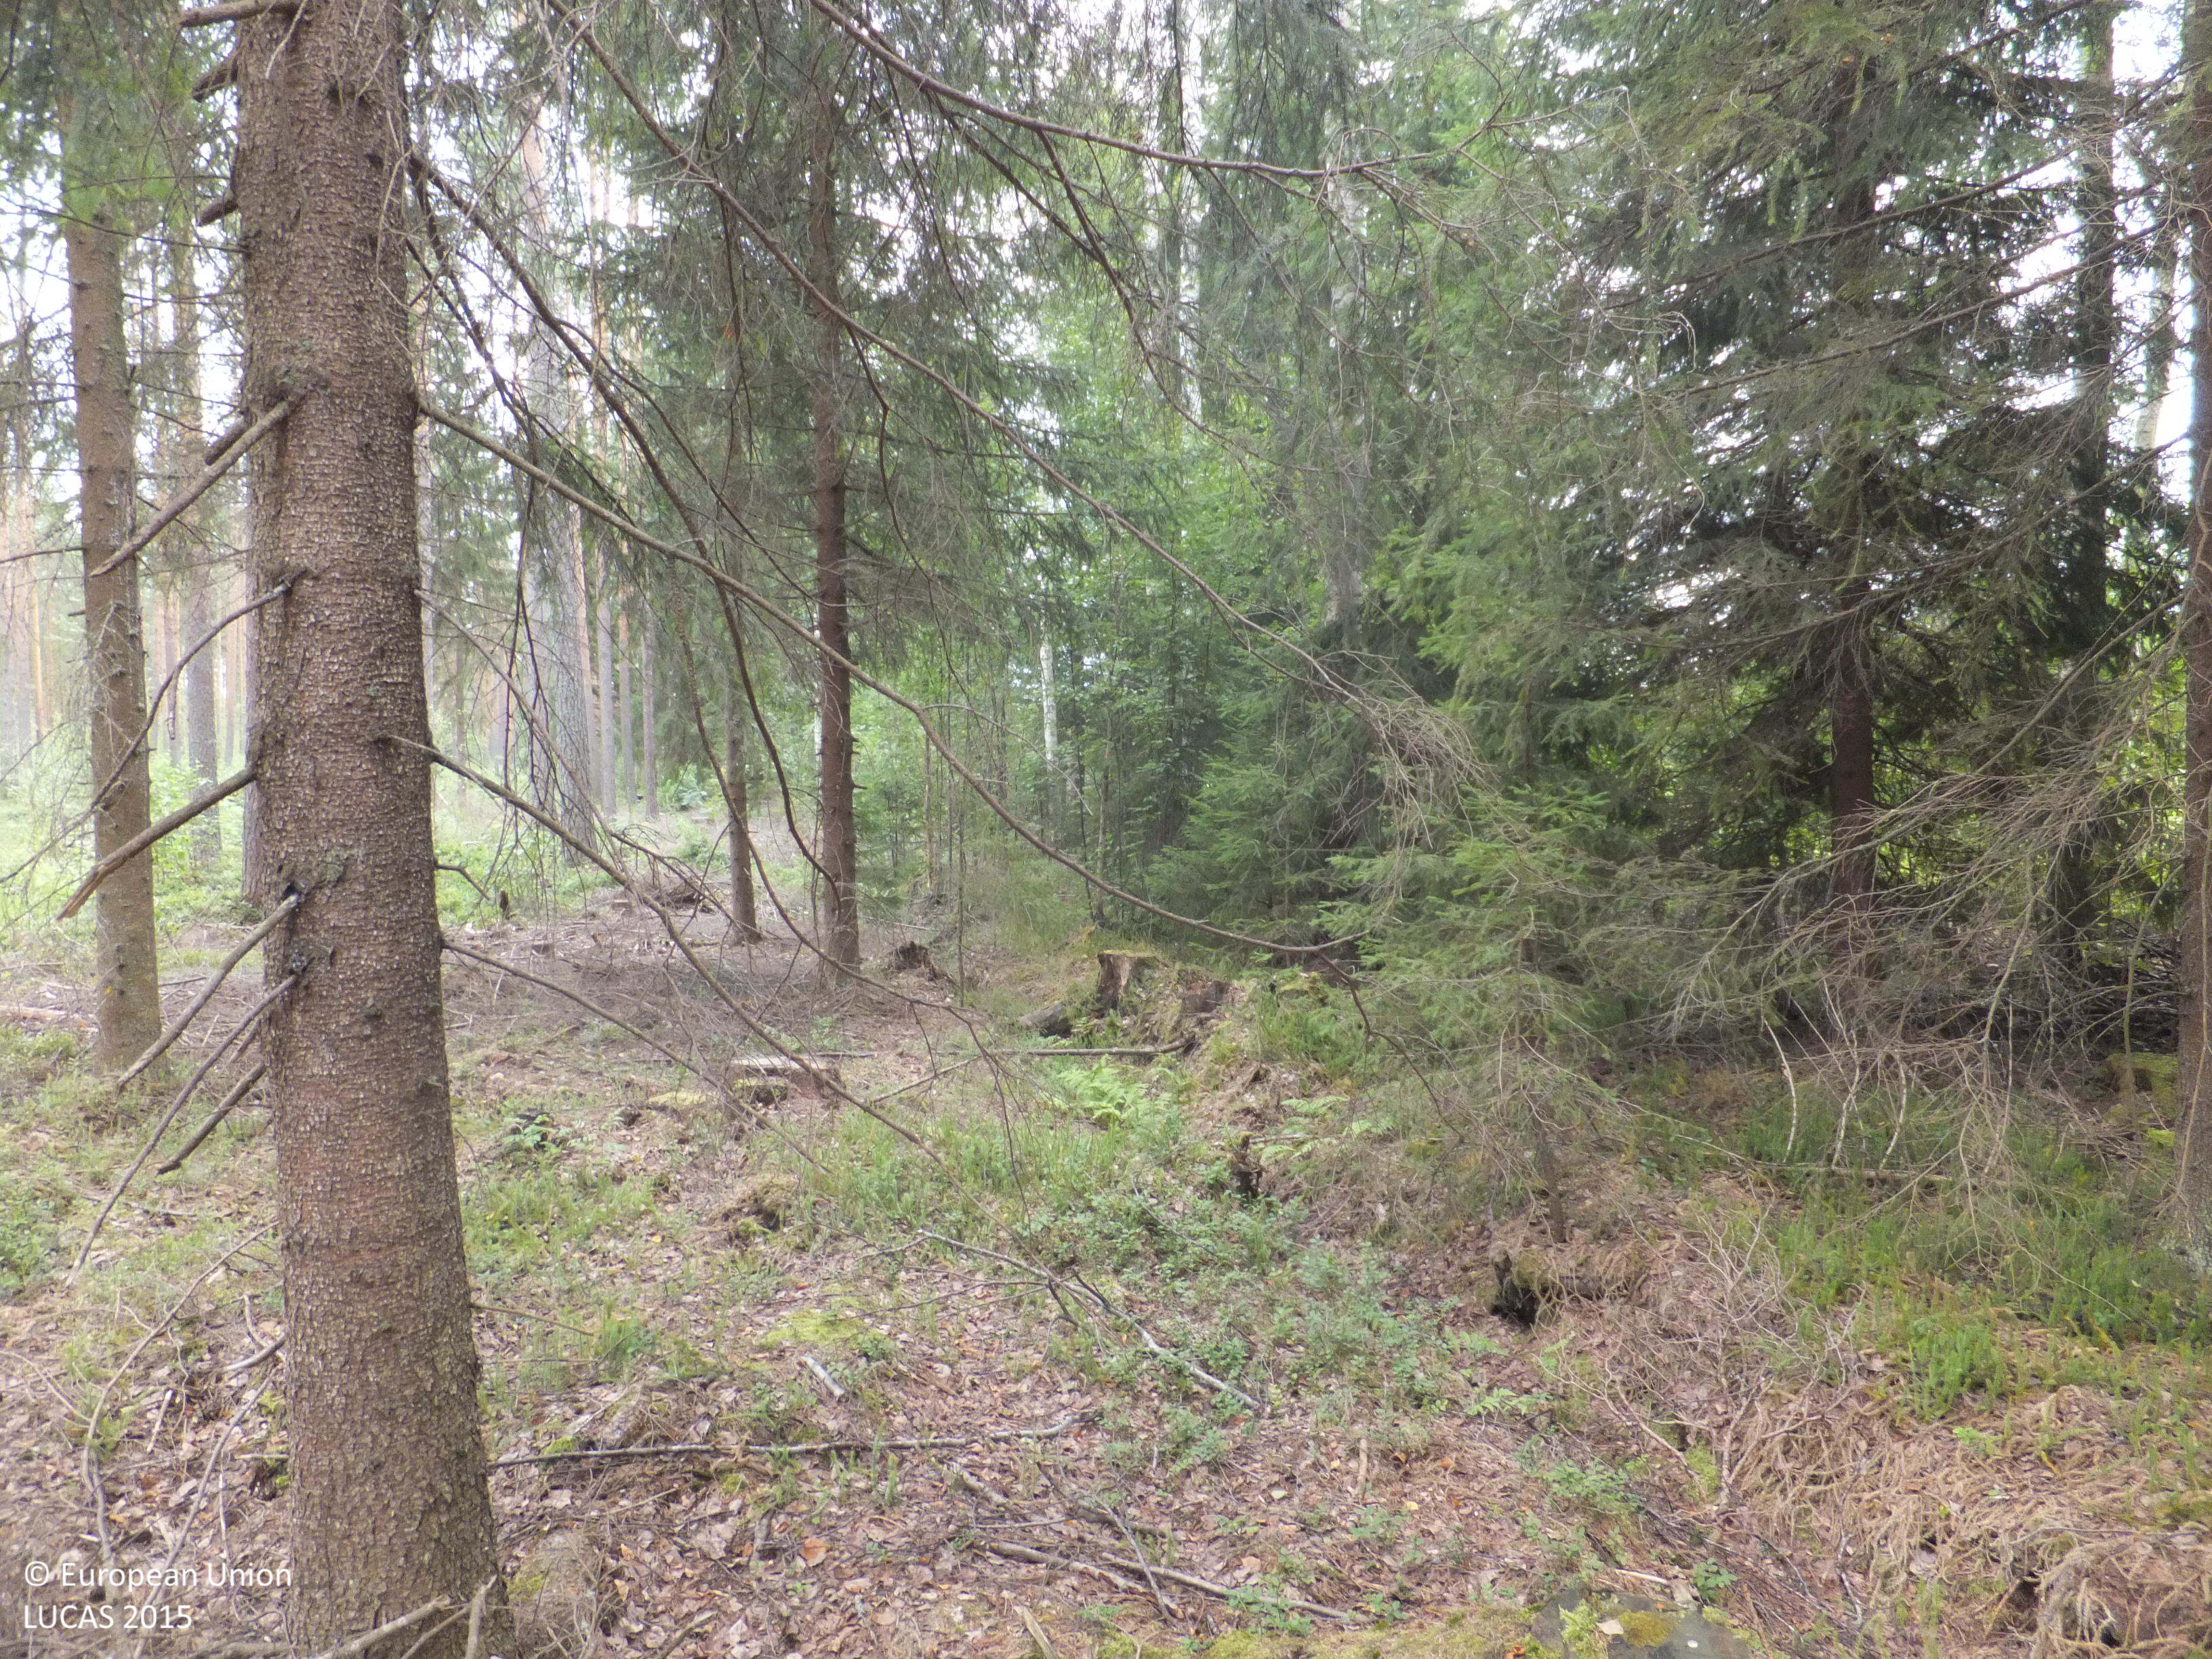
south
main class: Woodland
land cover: Spruce dominated mixed woodland
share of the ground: > 75 %
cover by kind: coniferous forest trees 40 %, broadleaved forest trees 40 %, shrubs 5 %, herbaceous plants 5 %, lichens and mosses 5 %, unconsolidated bare surface 5 %
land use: Forestry
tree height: > 5 m
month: August
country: FI
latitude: 63.0702
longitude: 23.0216
